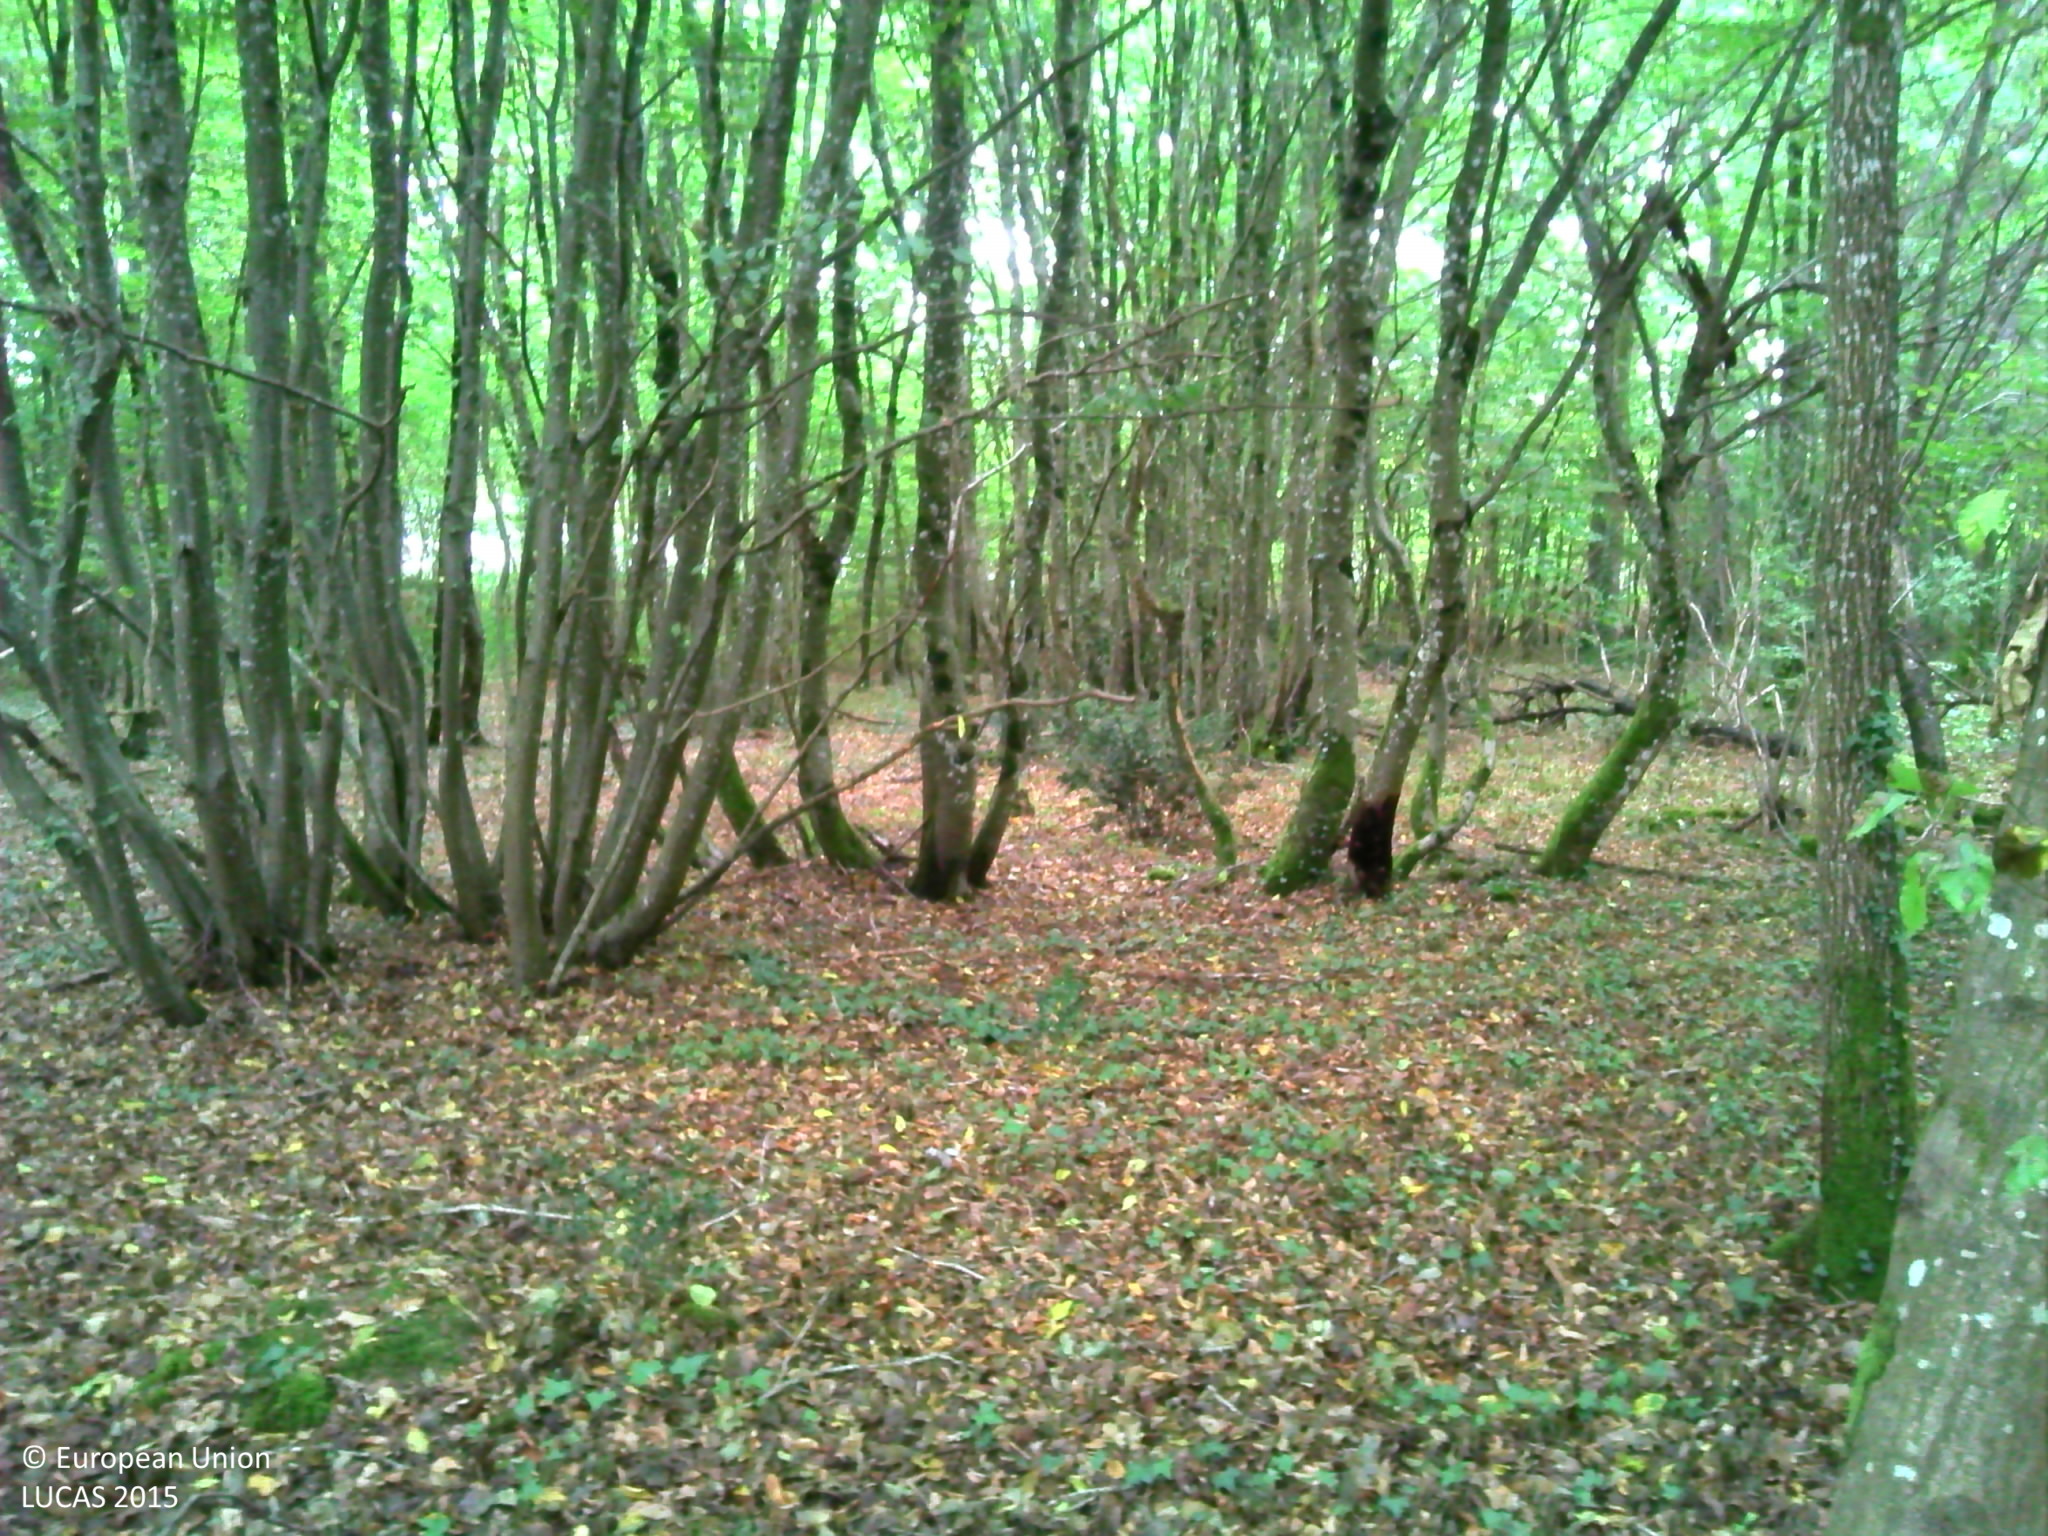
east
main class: Woodland
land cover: Broadleaved woodland
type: acidophilous oak and oak-birch forest
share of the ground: > 75 %
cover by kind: broadleaved forest trees 60 %, unconsolidated bare surface 30 %, herbaceous plants 10 %
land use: Forestry
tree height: > 5 m
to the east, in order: Broadleaved woodland; Grass margins; Rape and turnip rape
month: August
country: FR
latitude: 48.1327
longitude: 2.8029
